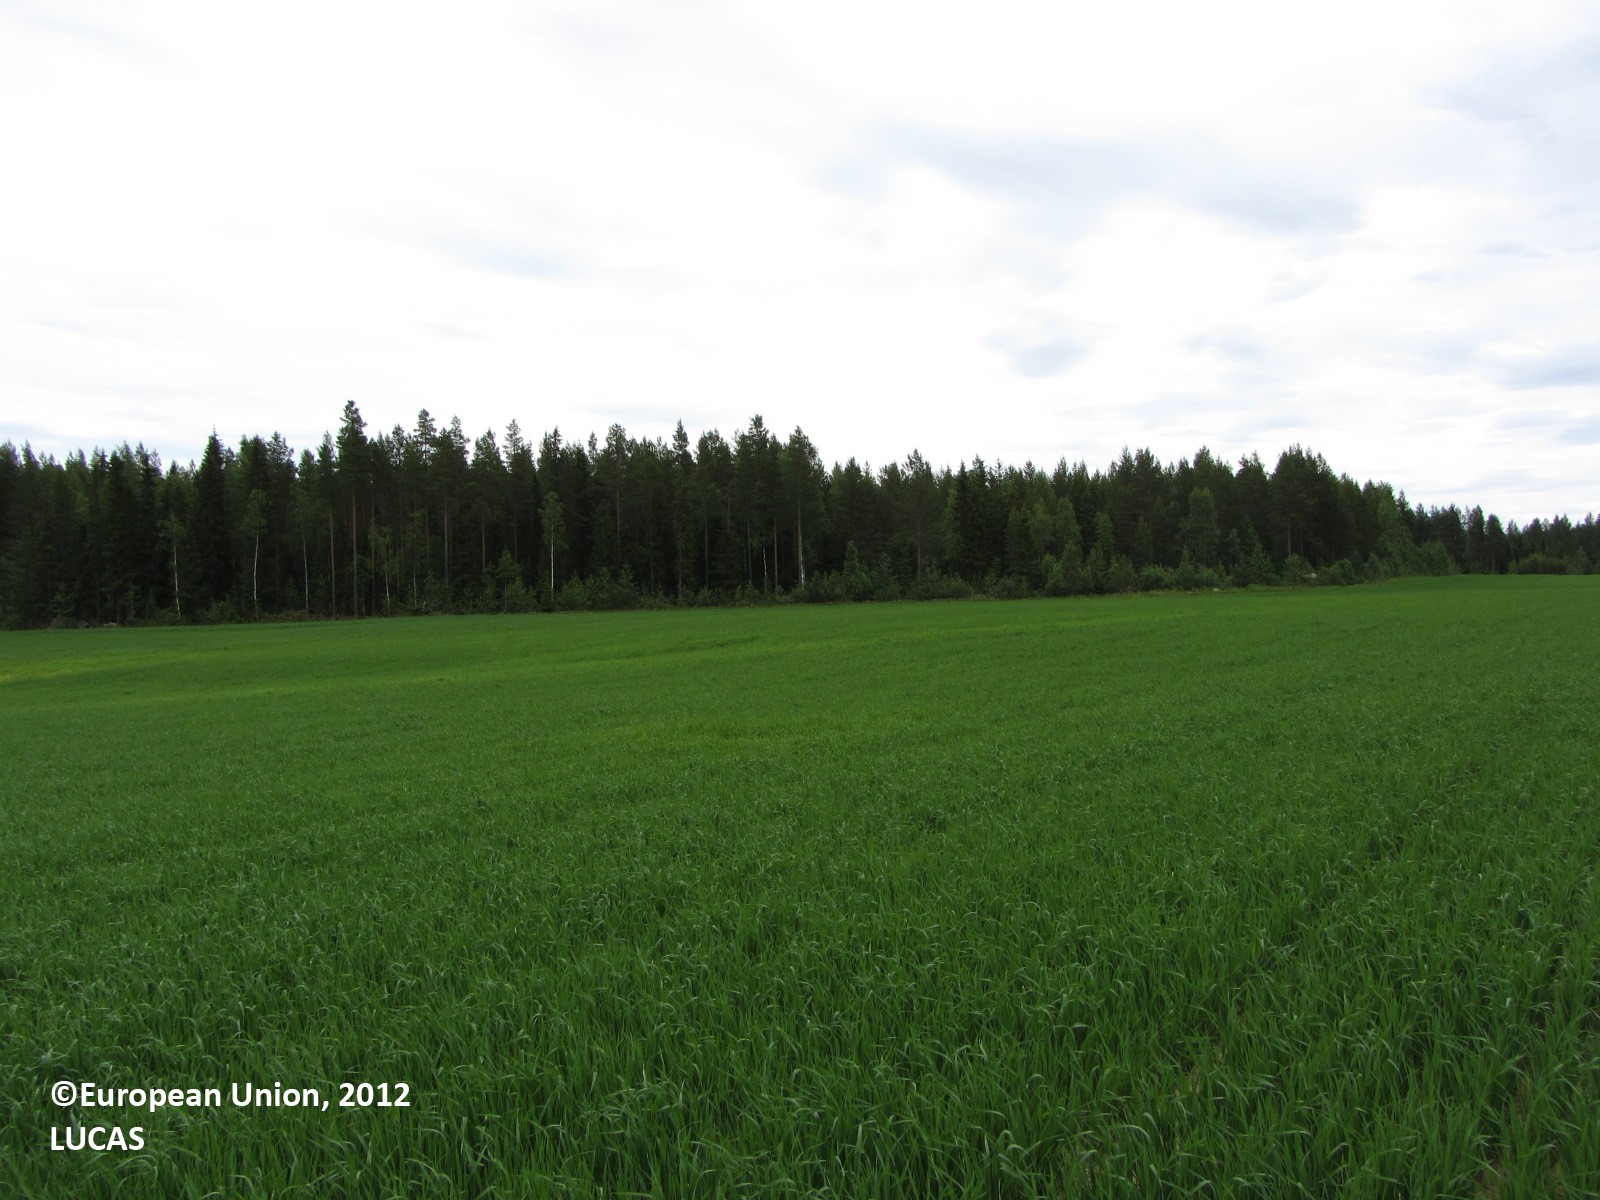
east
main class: Cropland
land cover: Oats
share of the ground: > 75 %
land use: Agriculture (excluding fallow land and kitchen gardens)
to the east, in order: Oats; Pine dominated mixed woodland
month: June
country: FI
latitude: 62.7849
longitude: 25.0933
